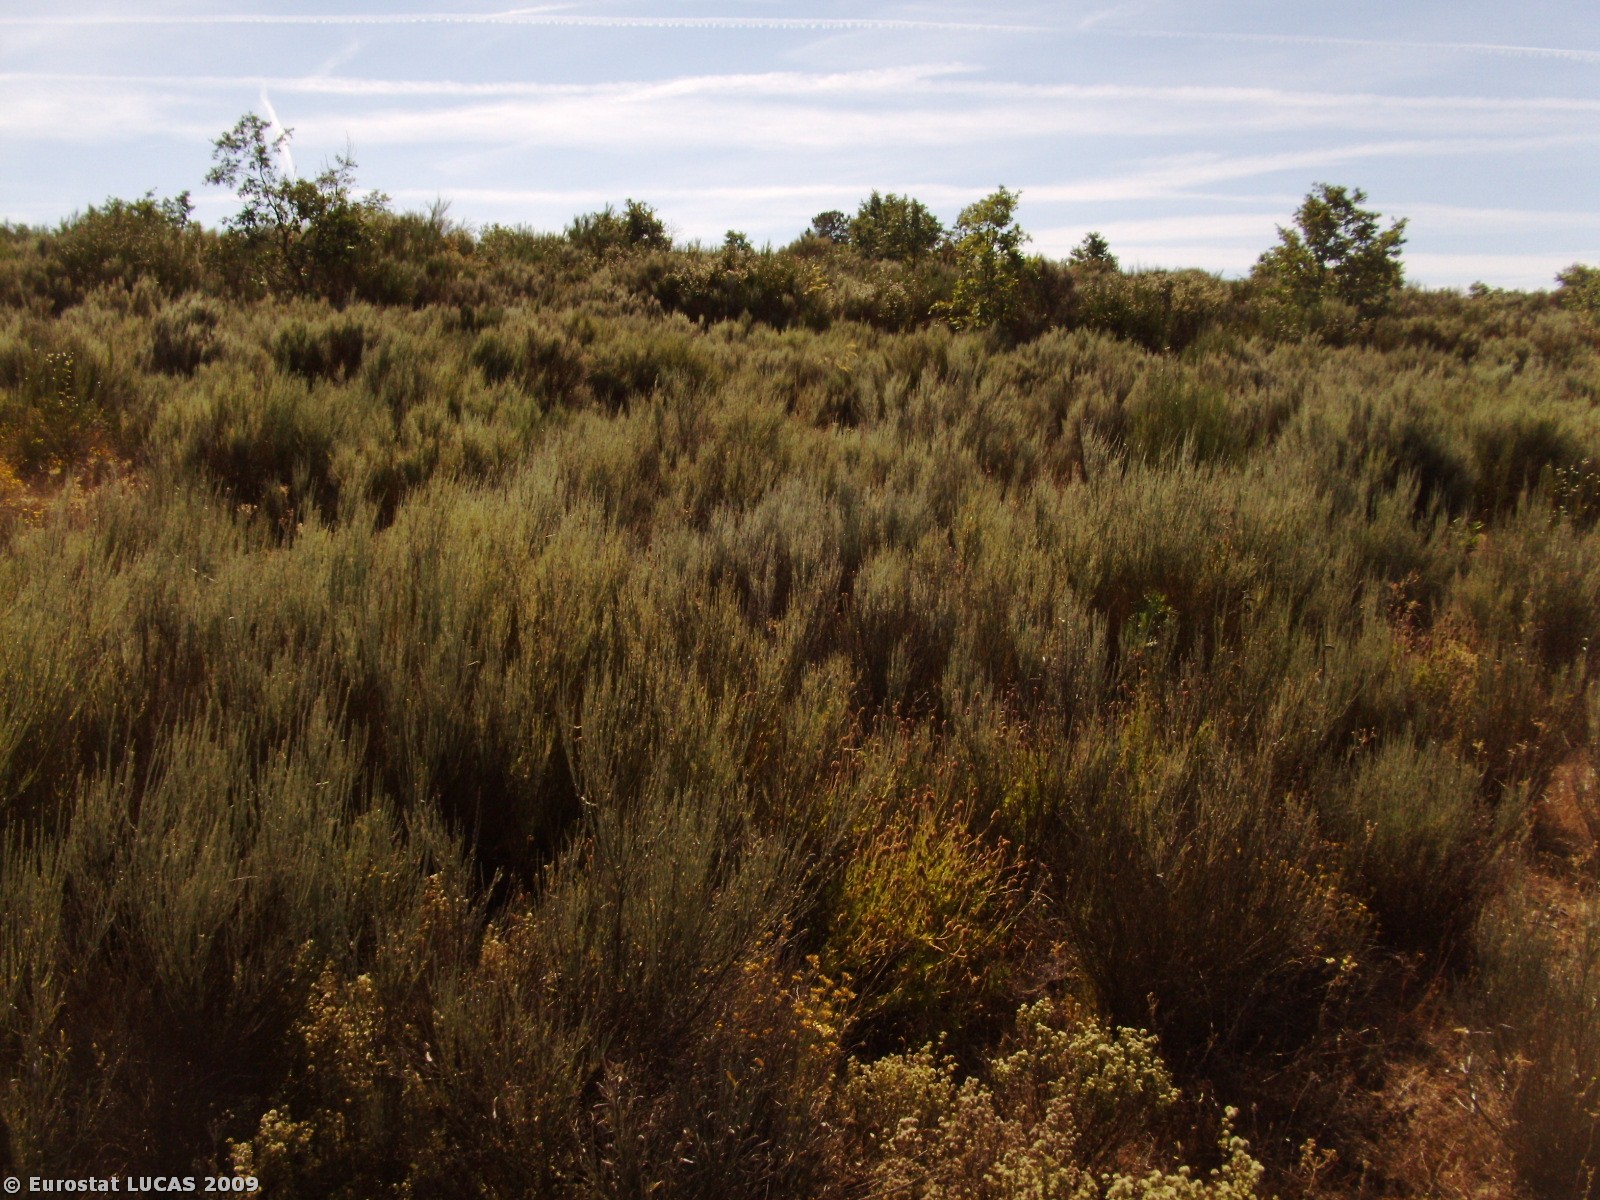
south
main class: Shrubland
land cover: Shrubland without tree cover
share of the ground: > 75 %
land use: Fallow land
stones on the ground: > 50 %
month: July
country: PT
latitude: 40.4556
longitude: -7.0684
